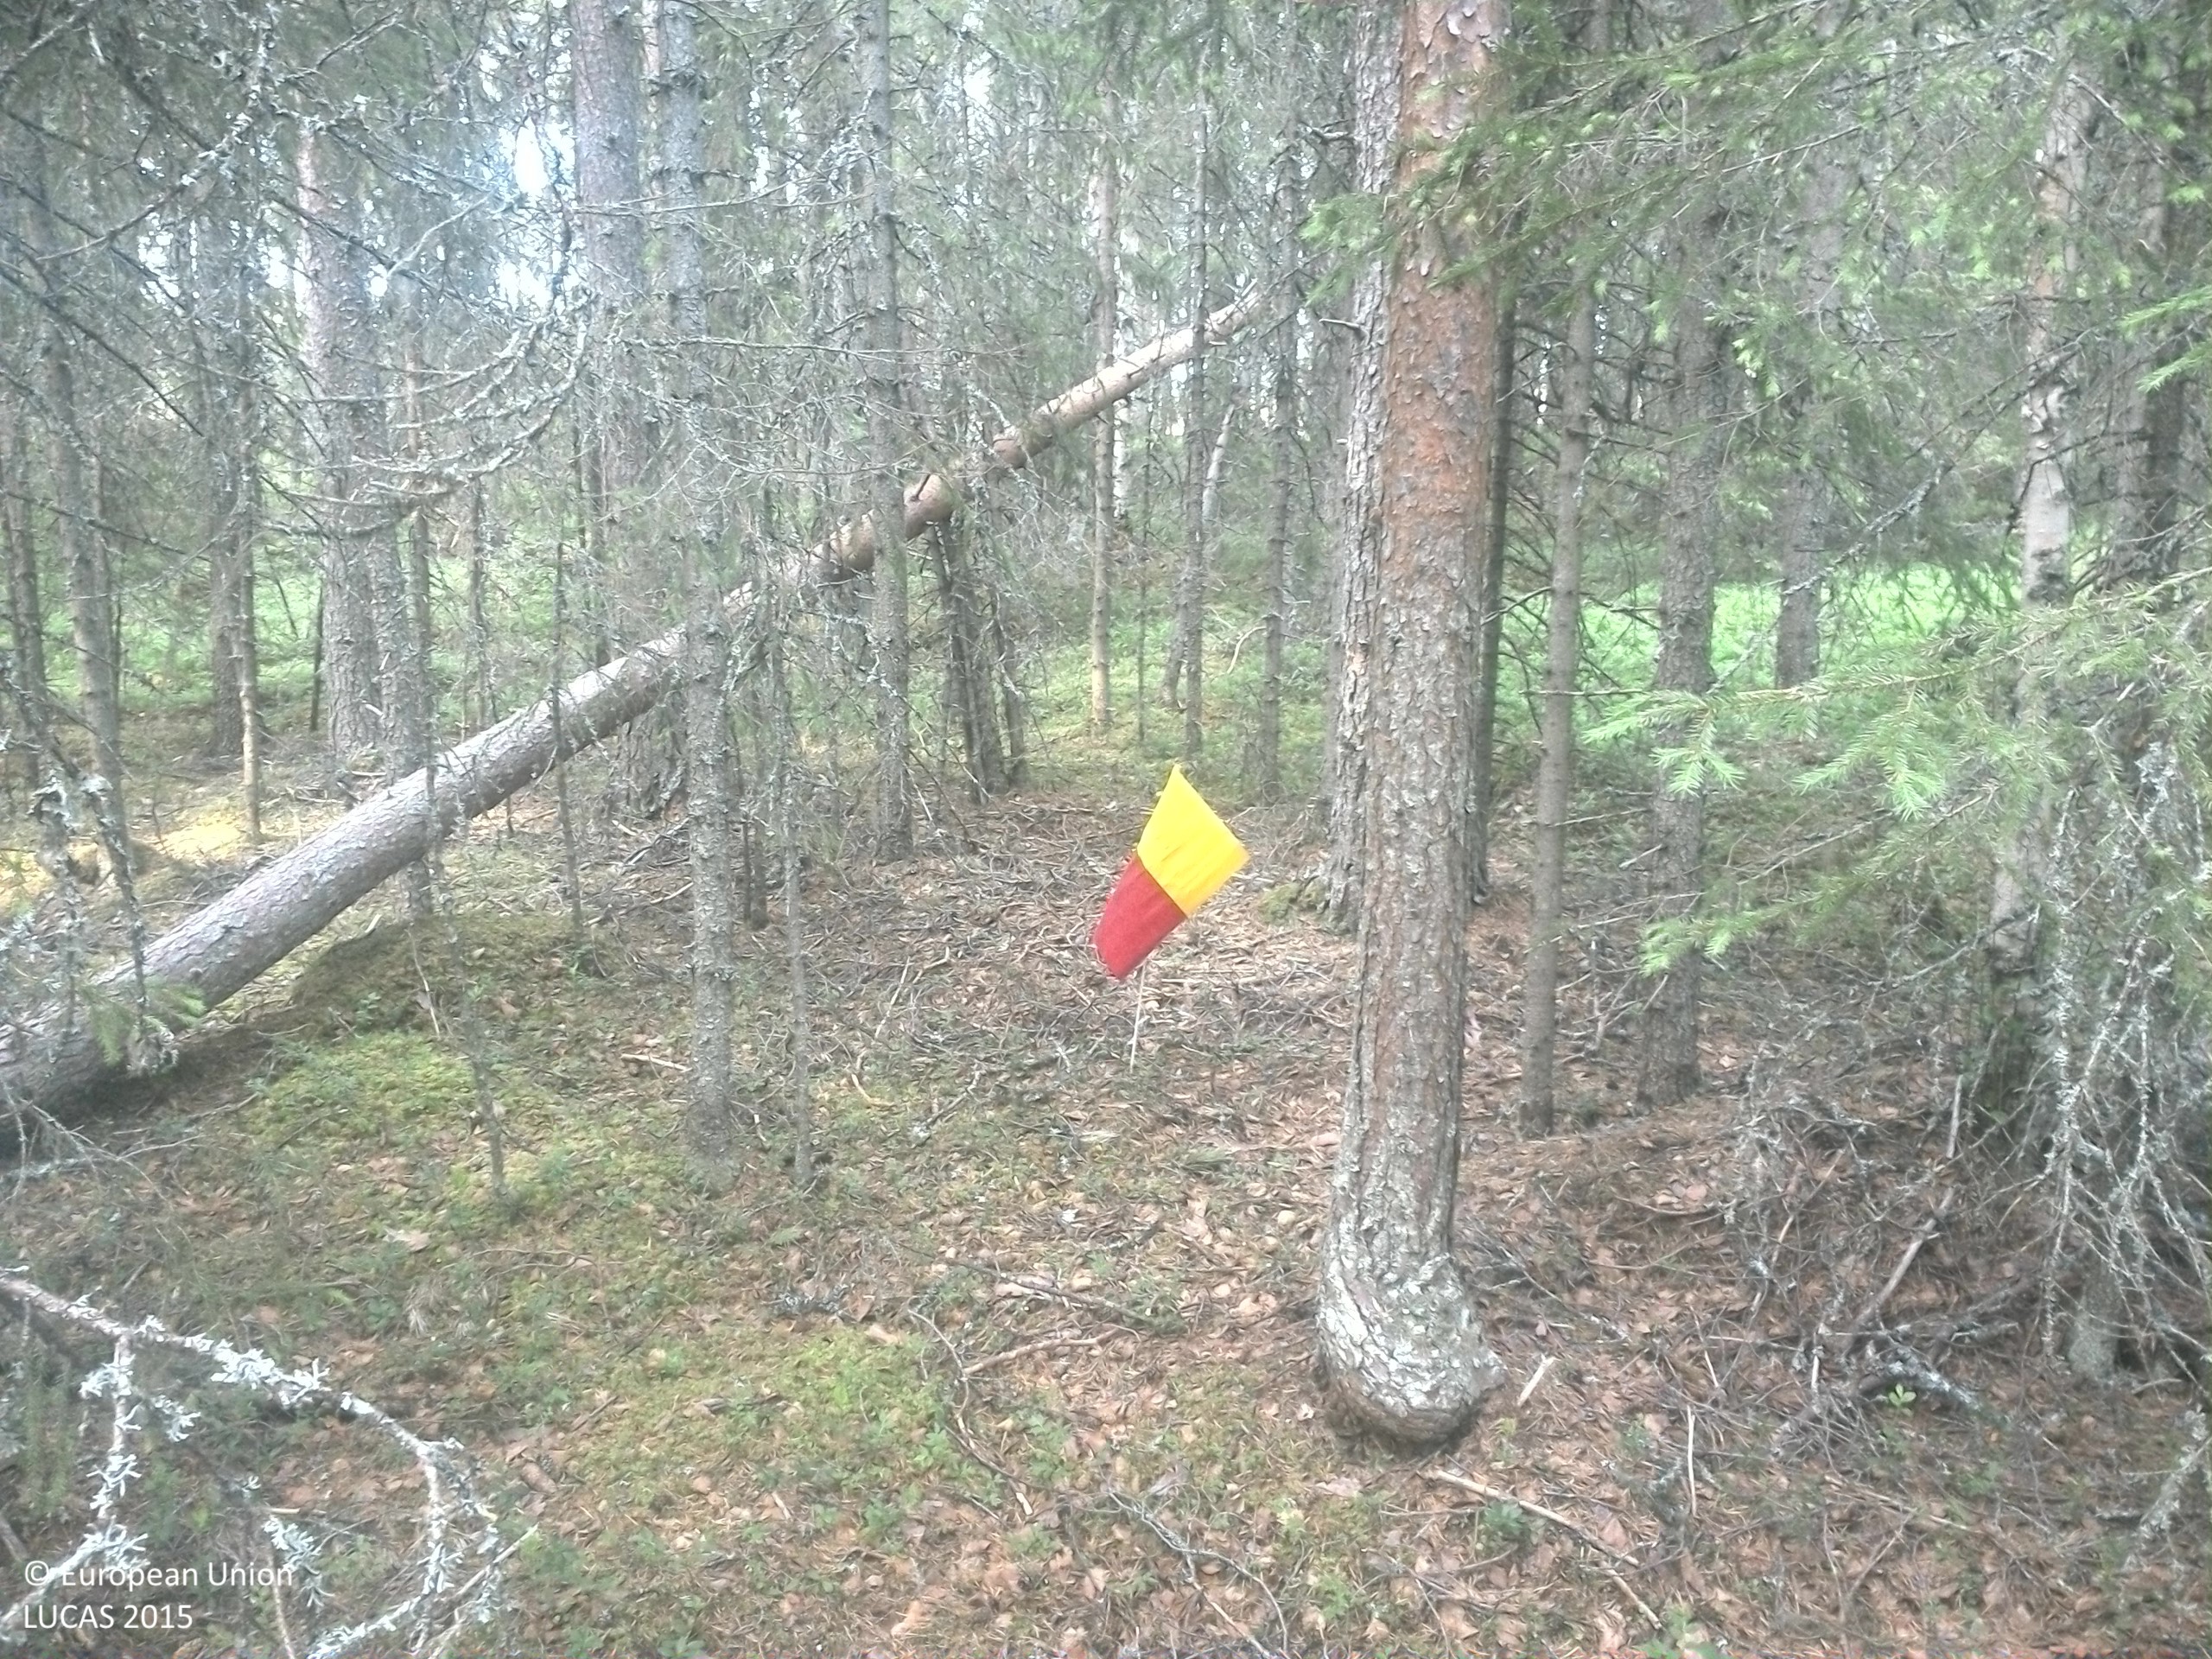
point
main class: Woodland
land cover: Spruce dominated coniferous woodland
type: boreal forest
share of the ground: > 75 %
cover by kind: coniferous forest trees 75 %, shrubs 10 %, herbaceous plants 10 %, broadleaved forest trees 5 %
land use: Forestry
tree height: > 5 m
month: July
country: SE
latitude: 64.6150
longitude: 15.8849
